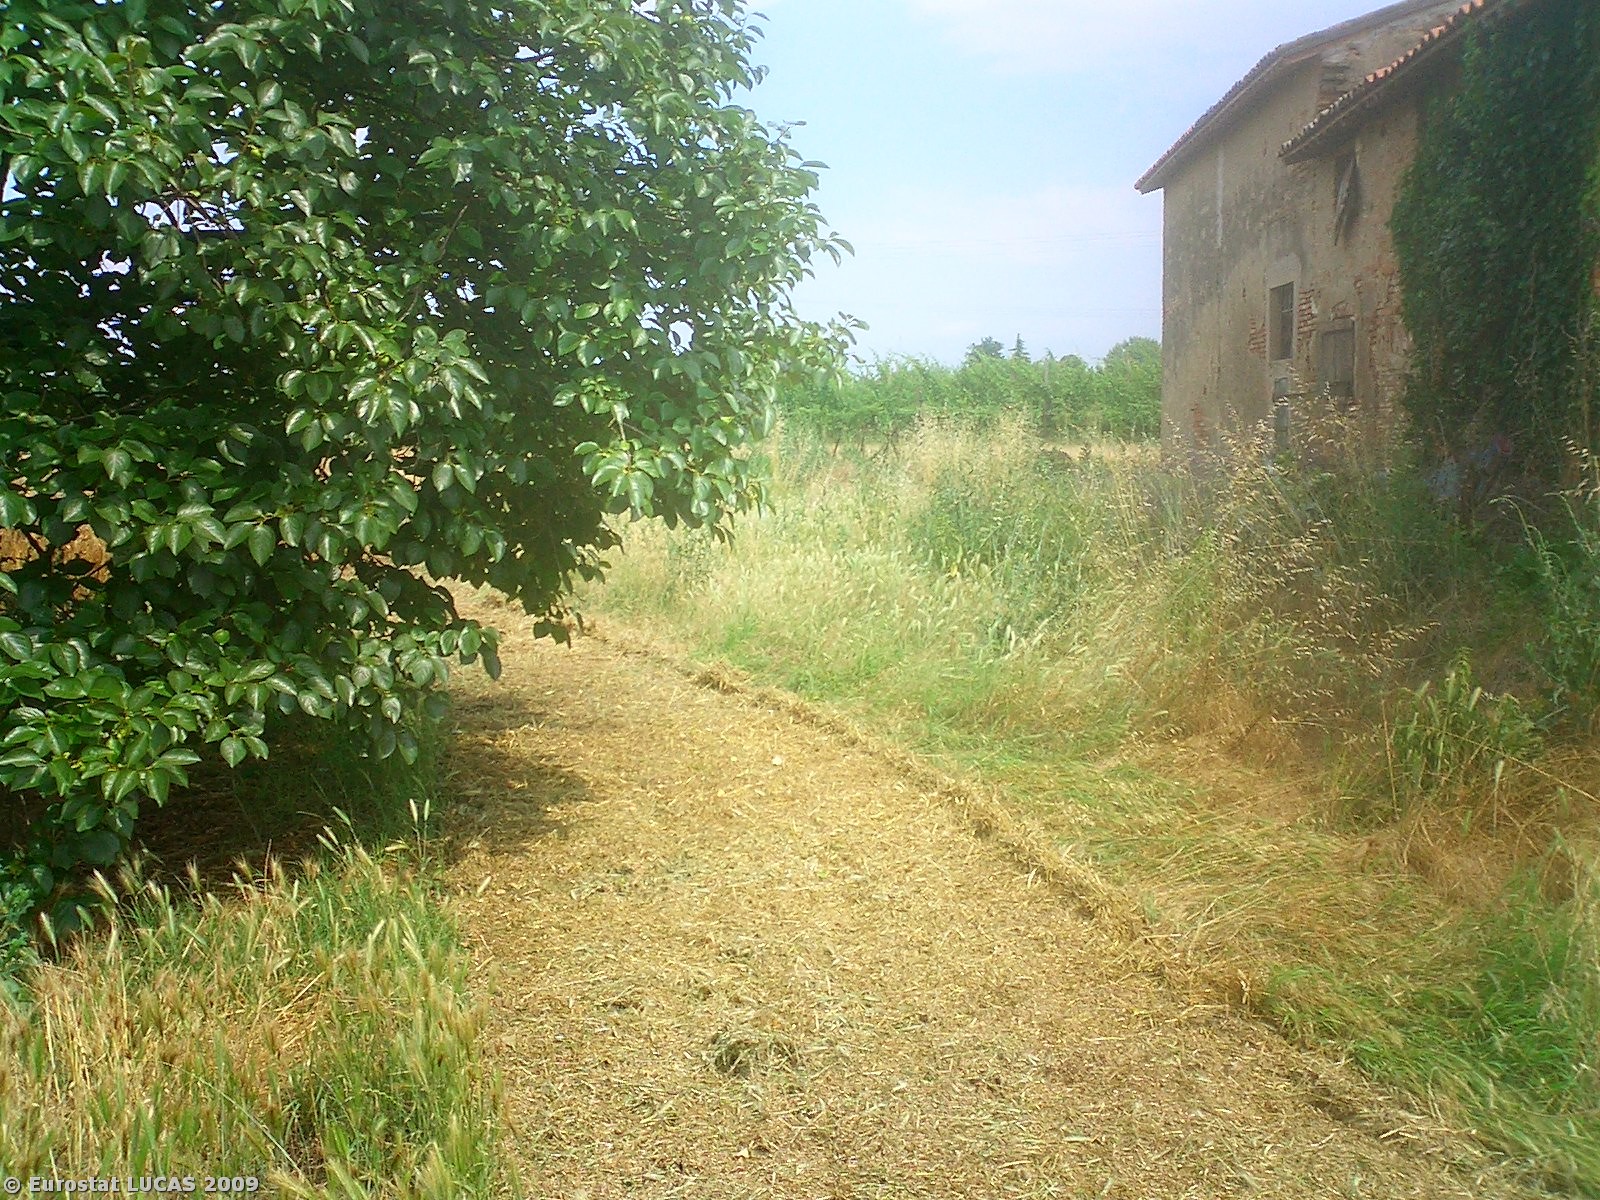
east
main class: Cropland
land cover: Durum wheat
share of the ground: > 75 %
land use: Agriculture (excluding fallow land and kitchen gardens)
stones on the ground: < 10 %
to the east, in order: Durum wheat; Ditches and canals; Paved roads, cycling and walking lanes; Ditches and canals; Vineyards; Grassland with sparse tree/shrub cover; Electric lines; Vineyards; Grassland with sparse tree/shrub cover; Other fruit trees and berries; Grassland with sparse tree/shrub cover; Vineyards; Grassland with sparse tree/shrub cover
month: June
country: IT
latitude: 44.4600
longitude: 11.8687
